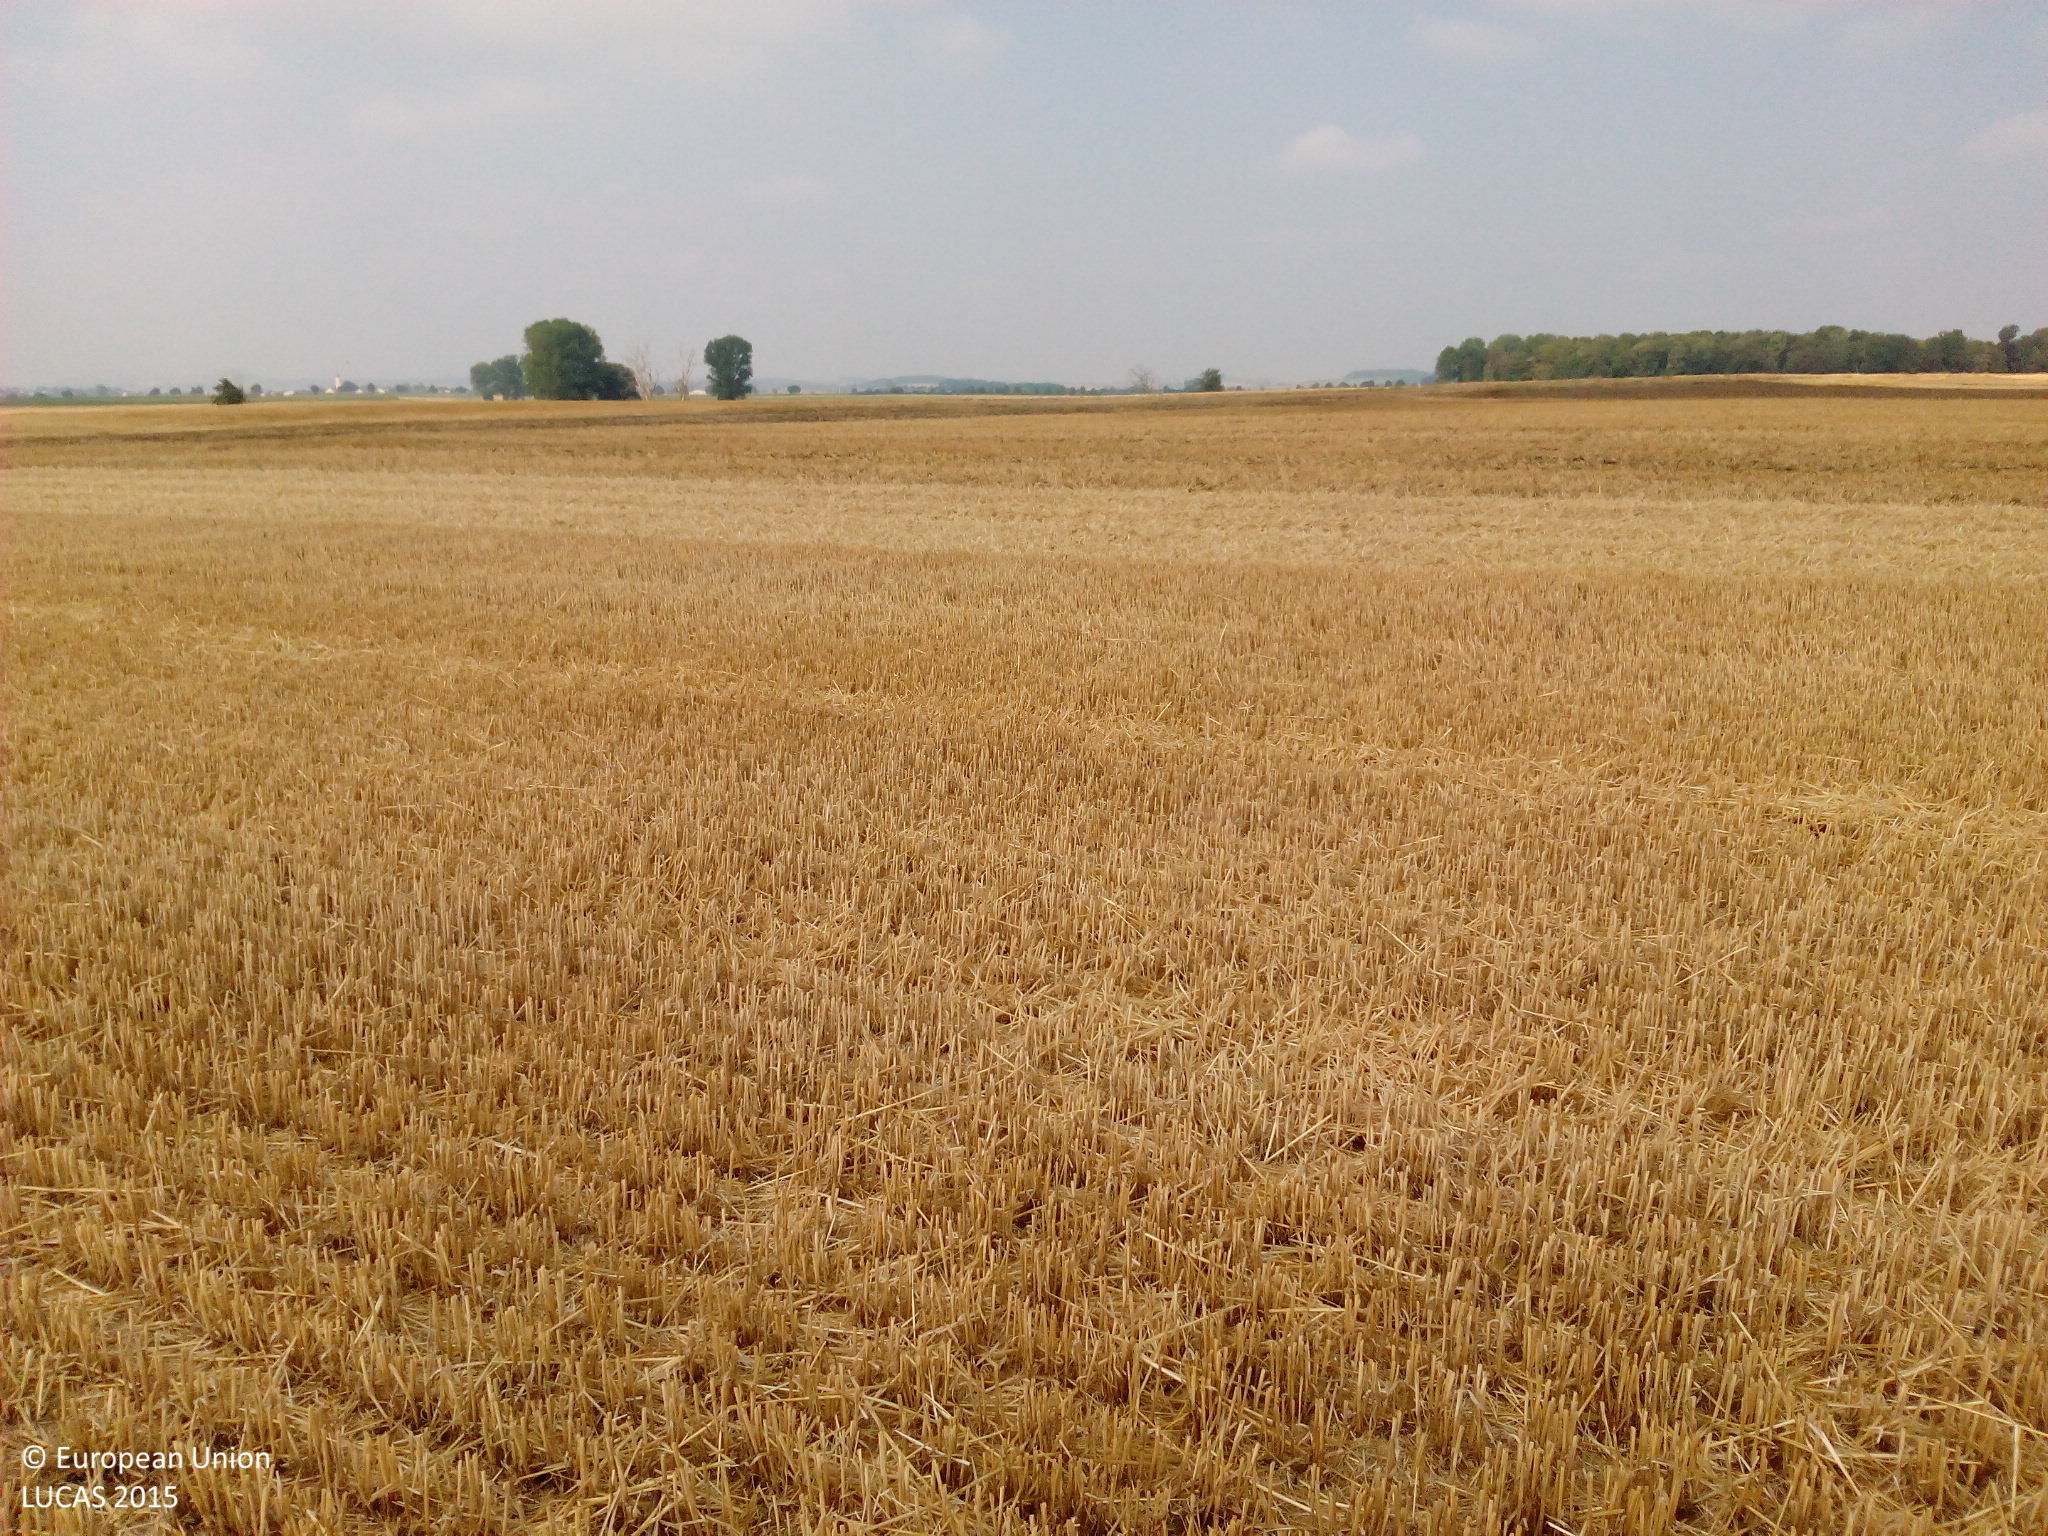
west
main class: Cropland
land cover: Common wheat
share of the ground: 50 - 75 %
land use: Agriculture (excluding fallow land and kitchen gardens)
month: August
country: DE
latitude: 48.9060
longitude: 10.5318
